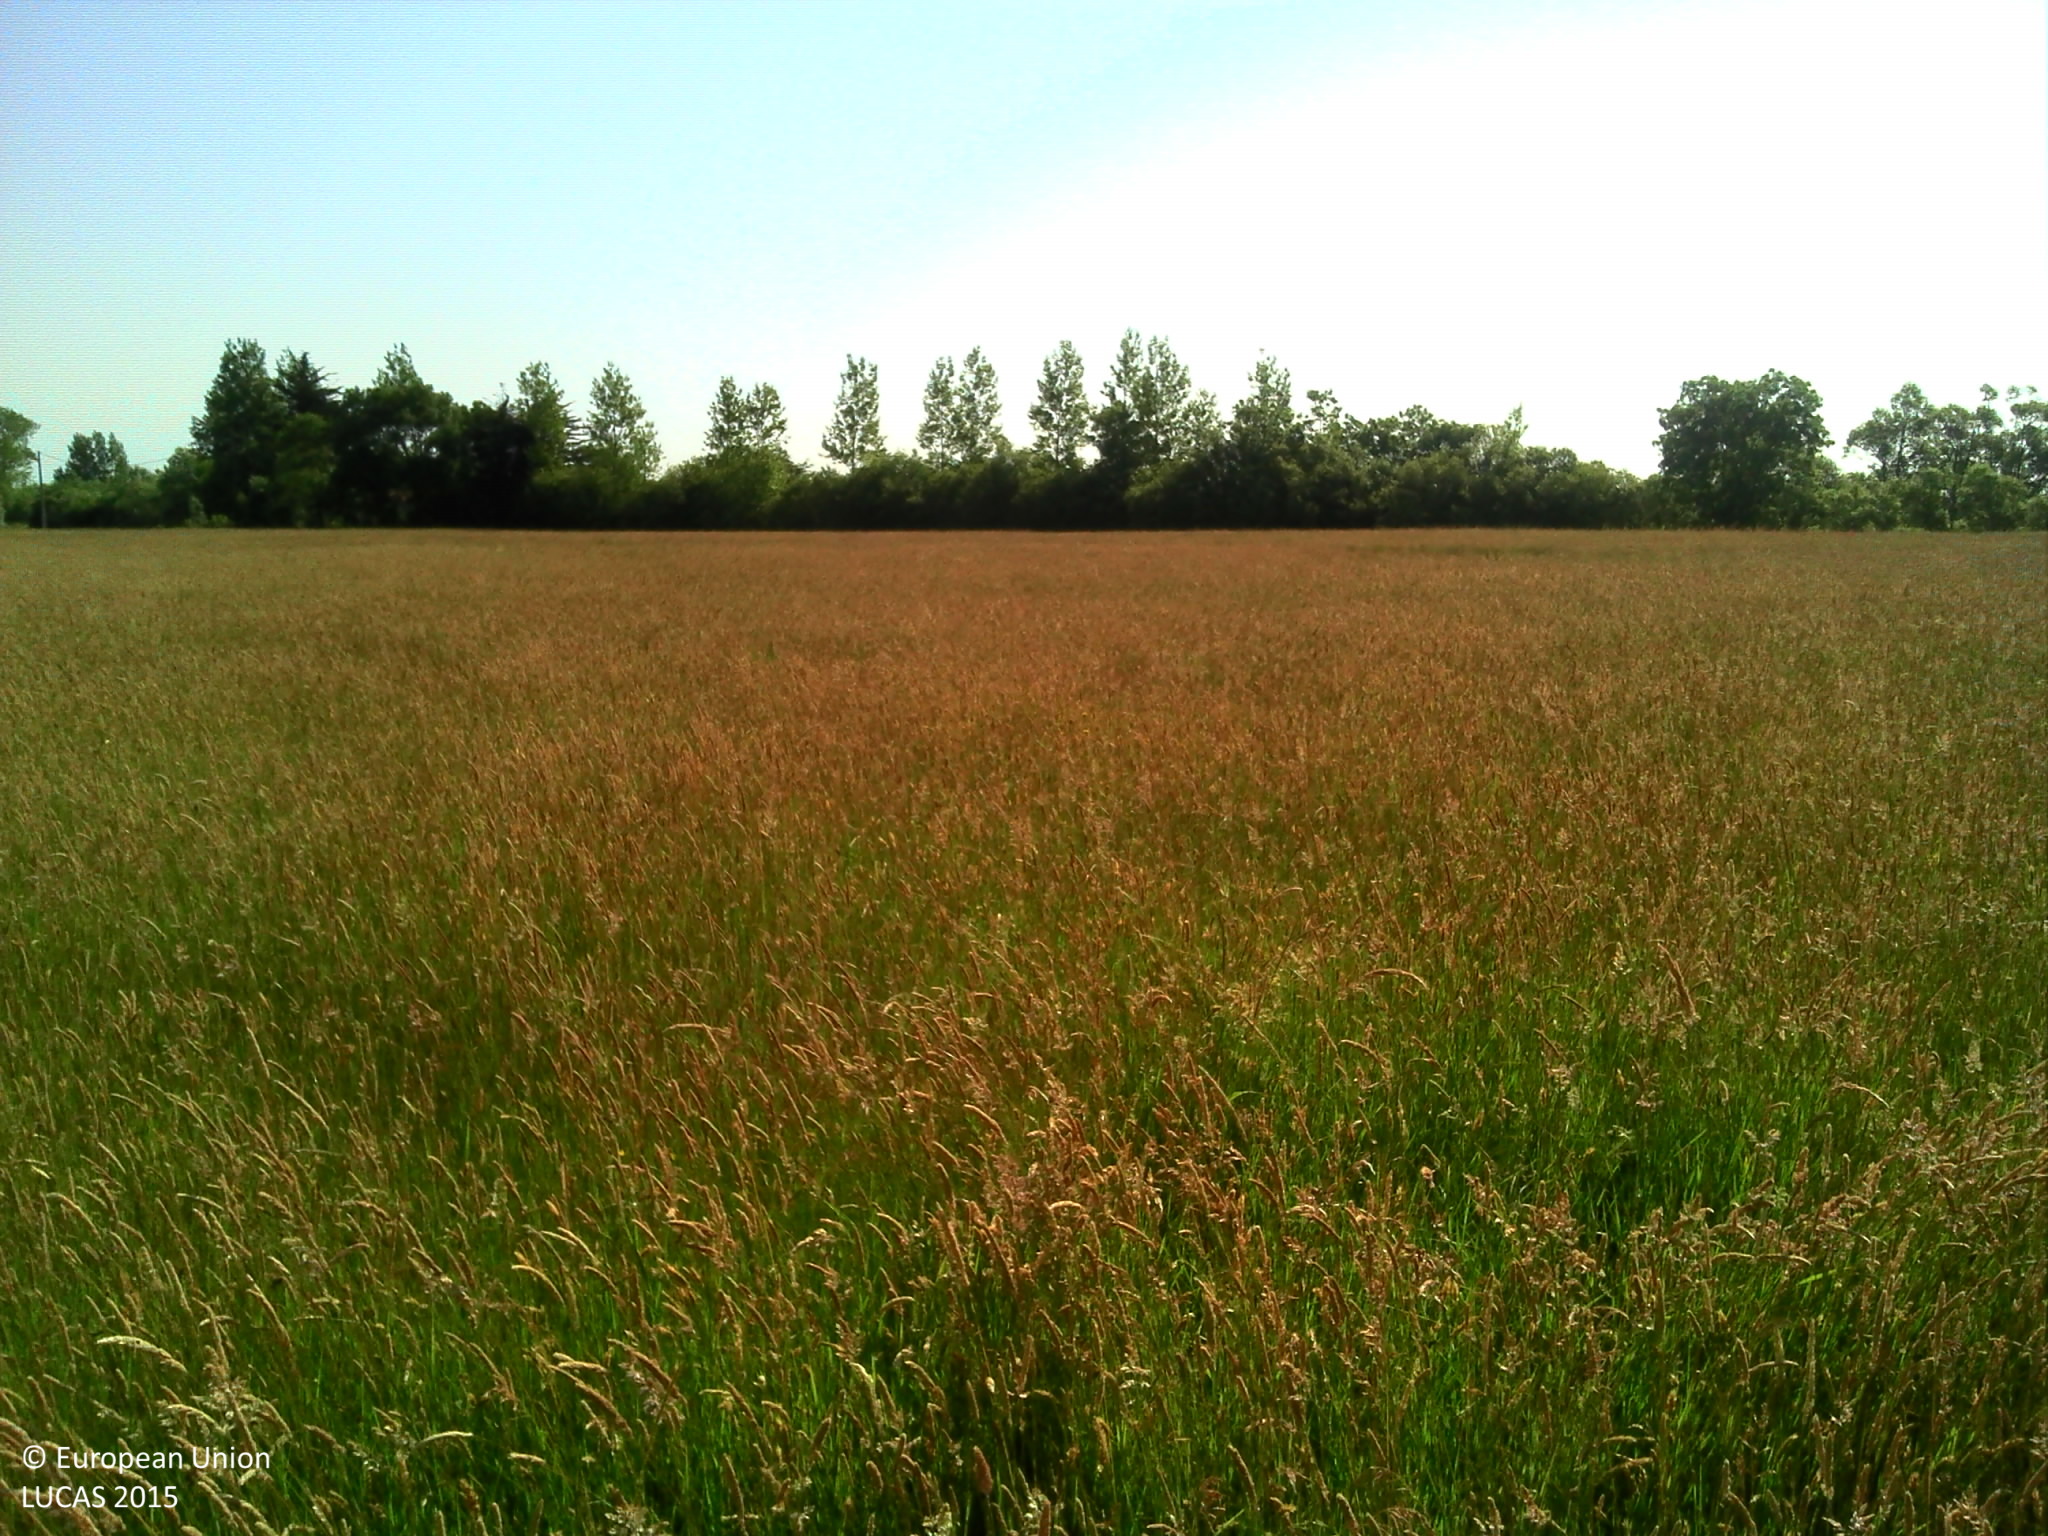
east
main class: Grassland
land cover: Grassland without tree/shrub cover
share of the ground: > 75 %
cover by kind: herbaceous plants 100 %
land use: Agriculture (excluding fallow land and kitchen gardens)
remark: Temporary flooded
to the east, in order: Grassland without tree/shrub cover; Ditches and canals; Lines of trees; Grass margins; Paved roads, cycling and walking lanes; Grass margins; Lines of trees; Rivers and streams; Fences; Grassland without tree/shrub cover; Fences; Rivers and streams; Grassland without tree/shrub cover; Rivers and streams; Grassland without tree/shrub cover
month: June
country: FR
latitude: 46.8386
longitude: -1.9909
